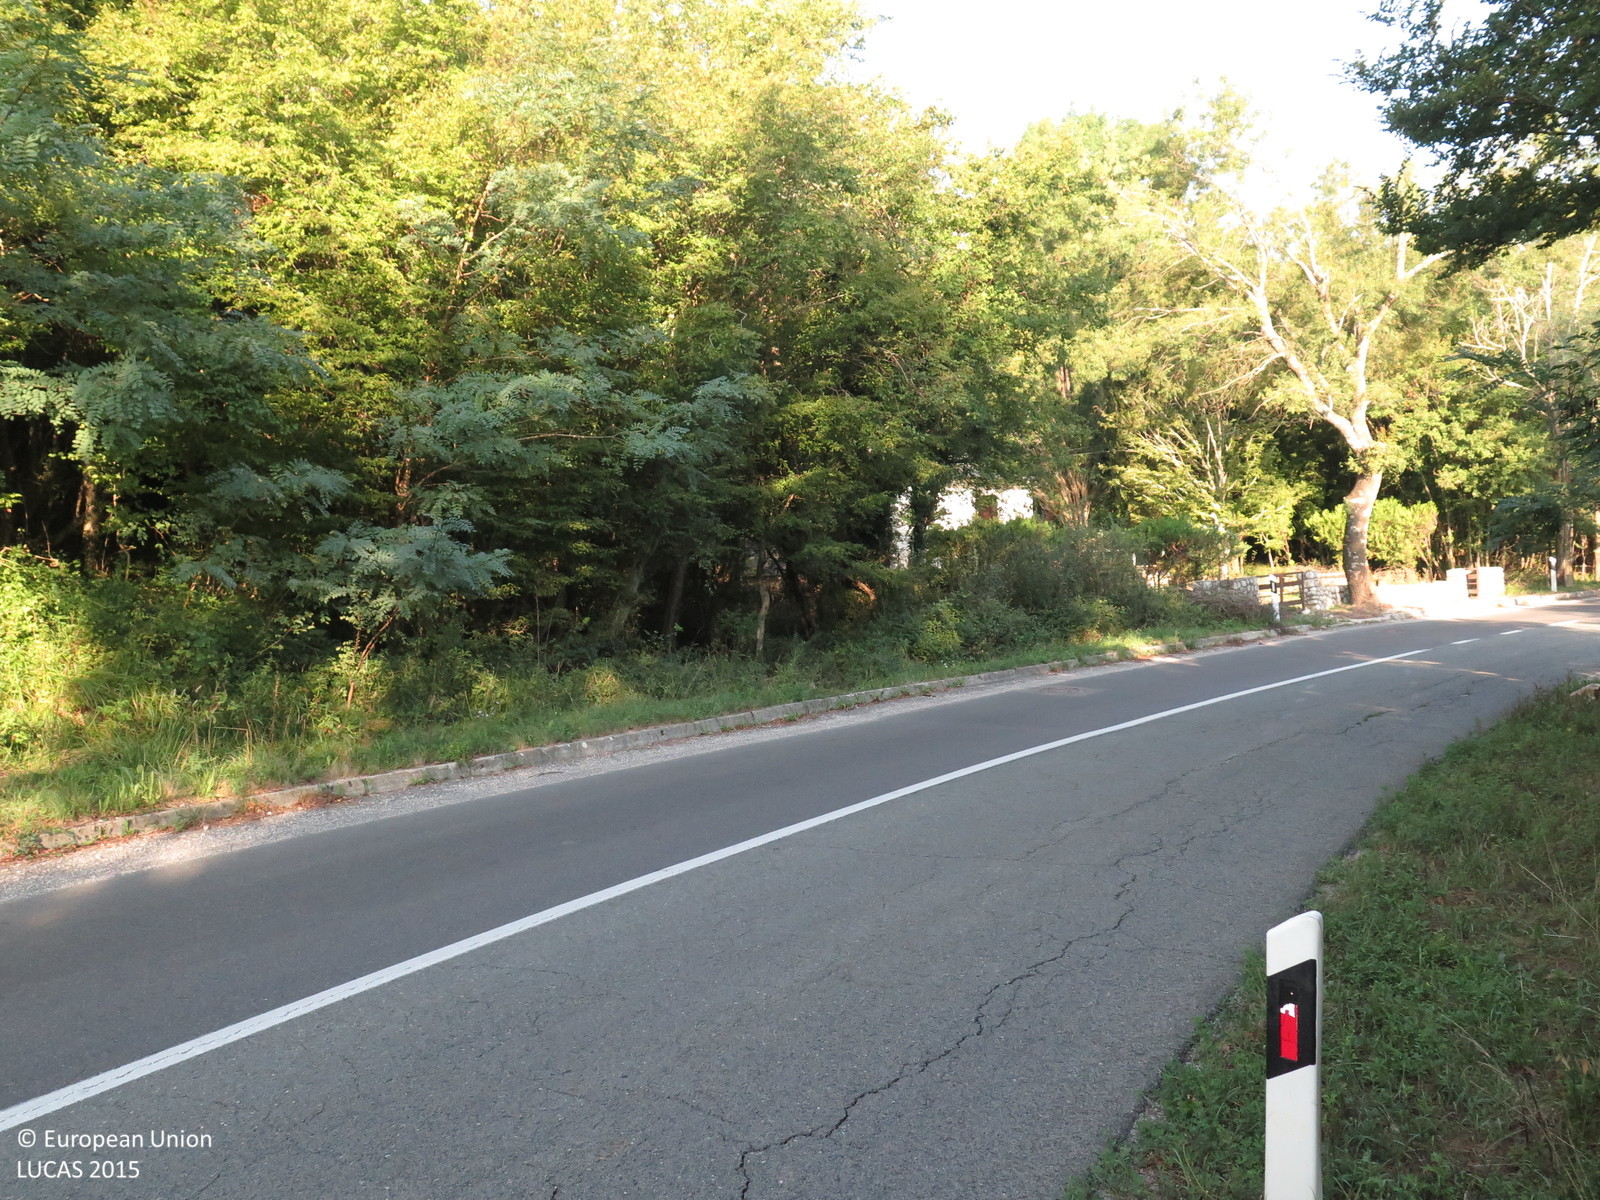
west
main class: Shrubland
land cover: Shrubland with sparse tree cover
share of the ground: > 75 %
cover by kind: shrubs 90 %, broadleaved forest trees 5 %, herbaceous plants 5 %
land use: Semi-natural and natural areas not in use
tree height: < 5 m
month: August
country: HR
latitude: 45.2015
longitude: 14.6923
